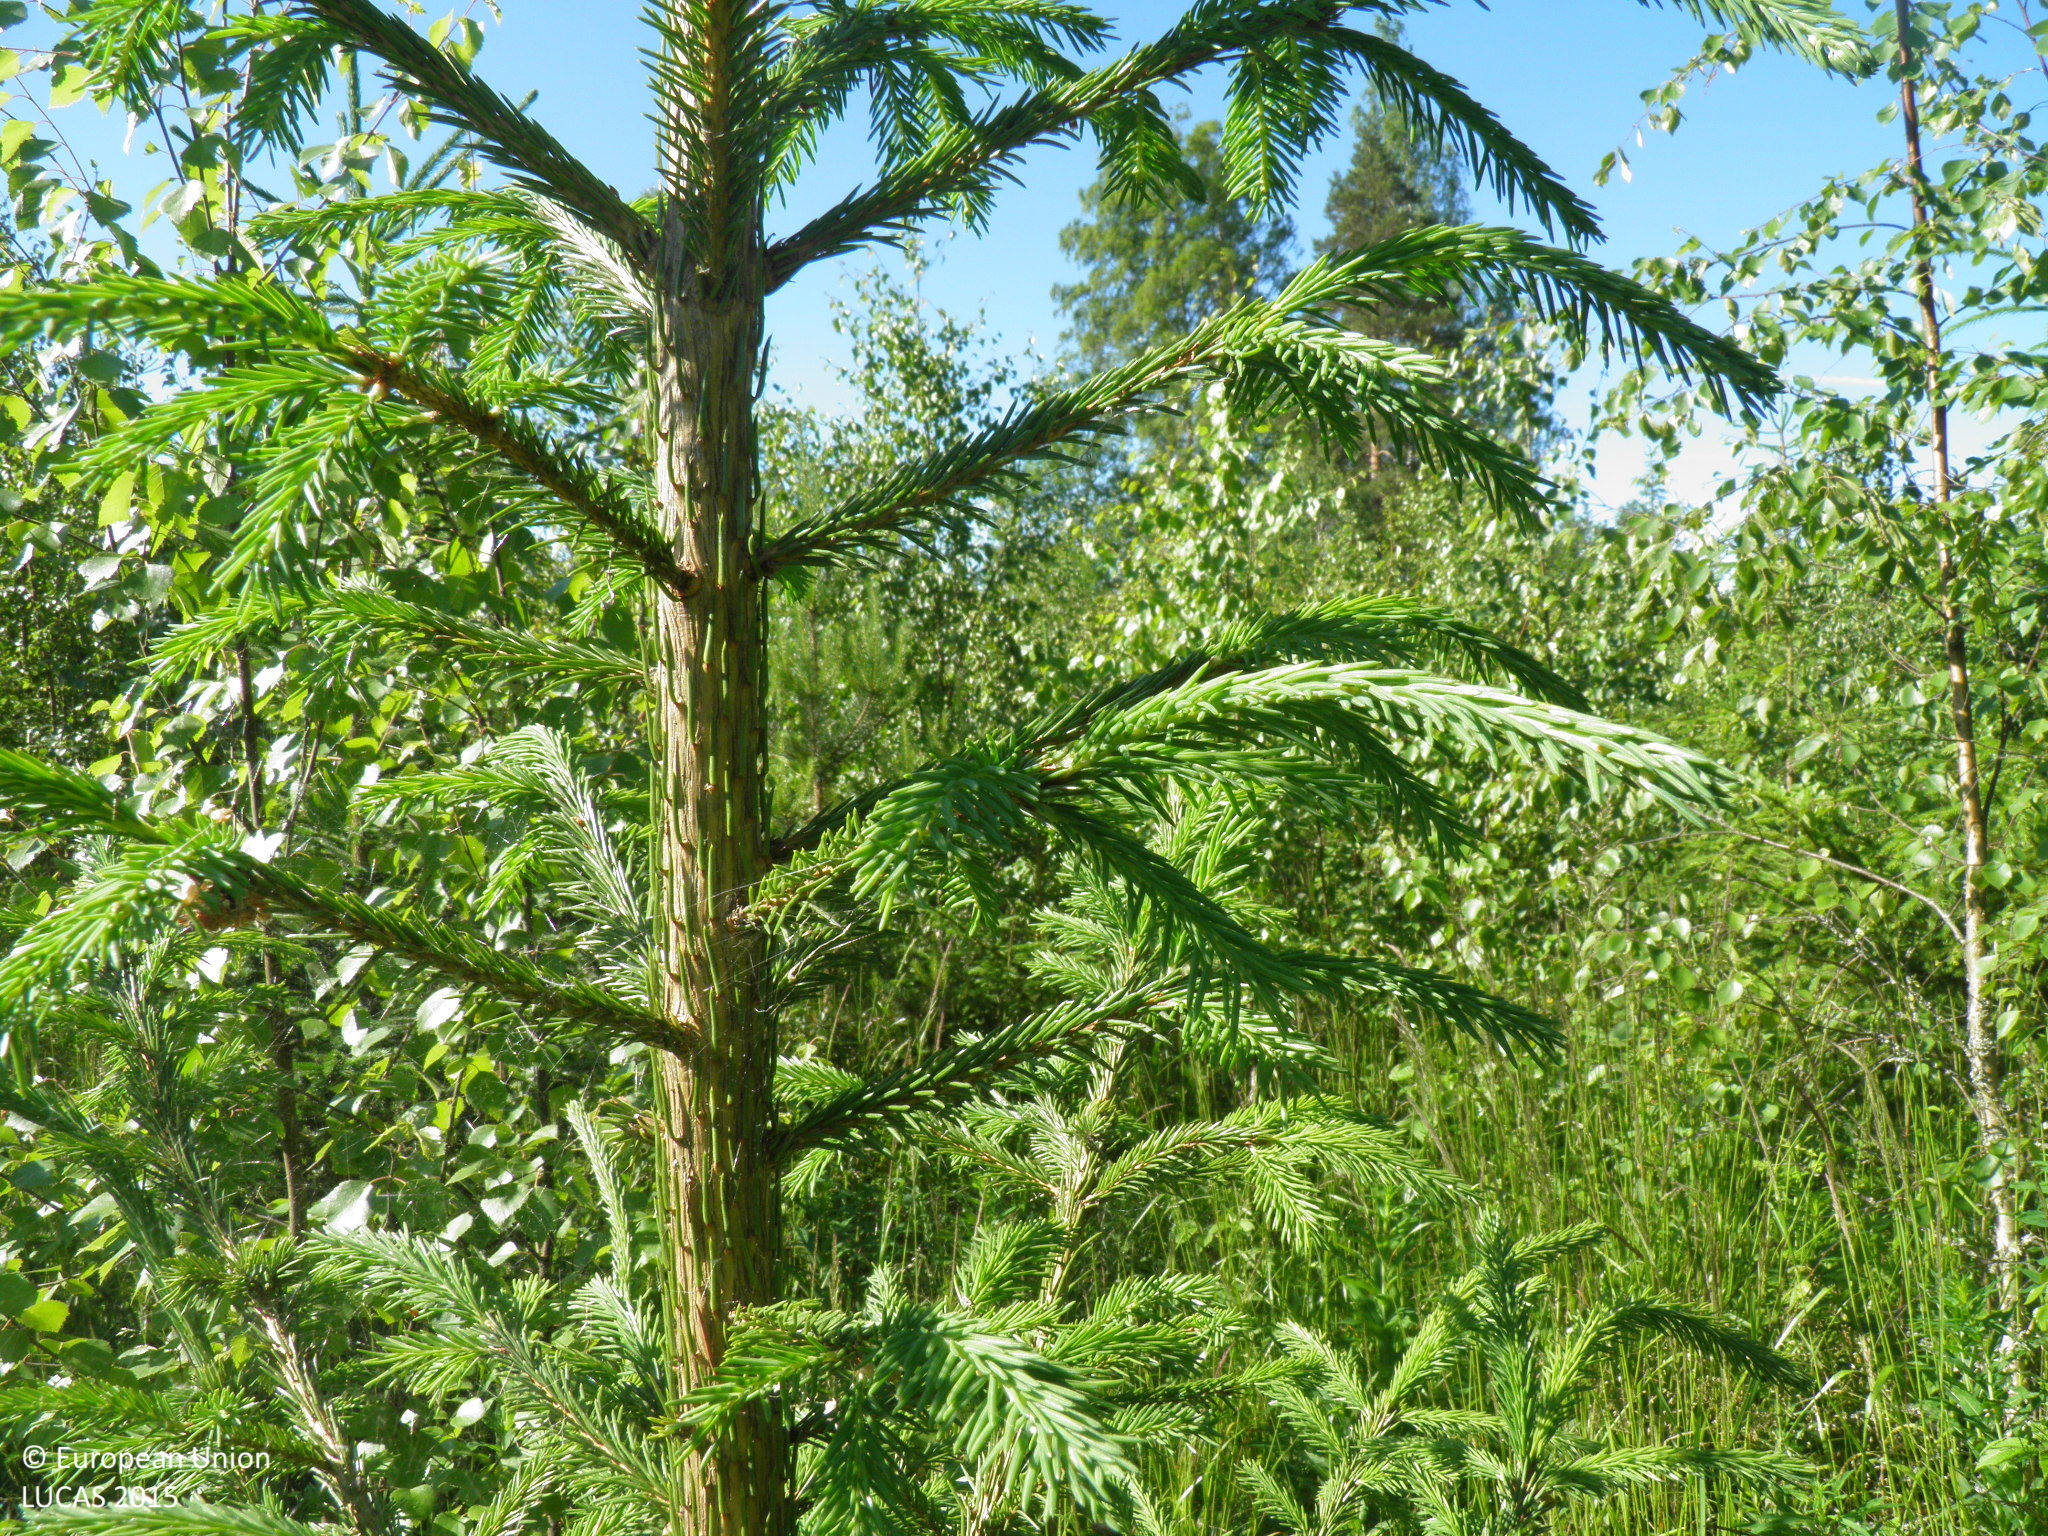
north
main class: Woodland
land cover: Other mixed woodland
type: hemiboreal forest and nemoral coniferous forest and mixed broadleaved-coniferous forest
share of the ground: 50 - 75 %
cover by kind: broadleaved forest trees 55 %, coniferous forest trees 20 %, herbaceous plants 15 %, shrubs 10 %
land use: Forestry
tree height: < 5 m
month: July
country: FI
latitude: 60.5256
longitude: 22.8105
